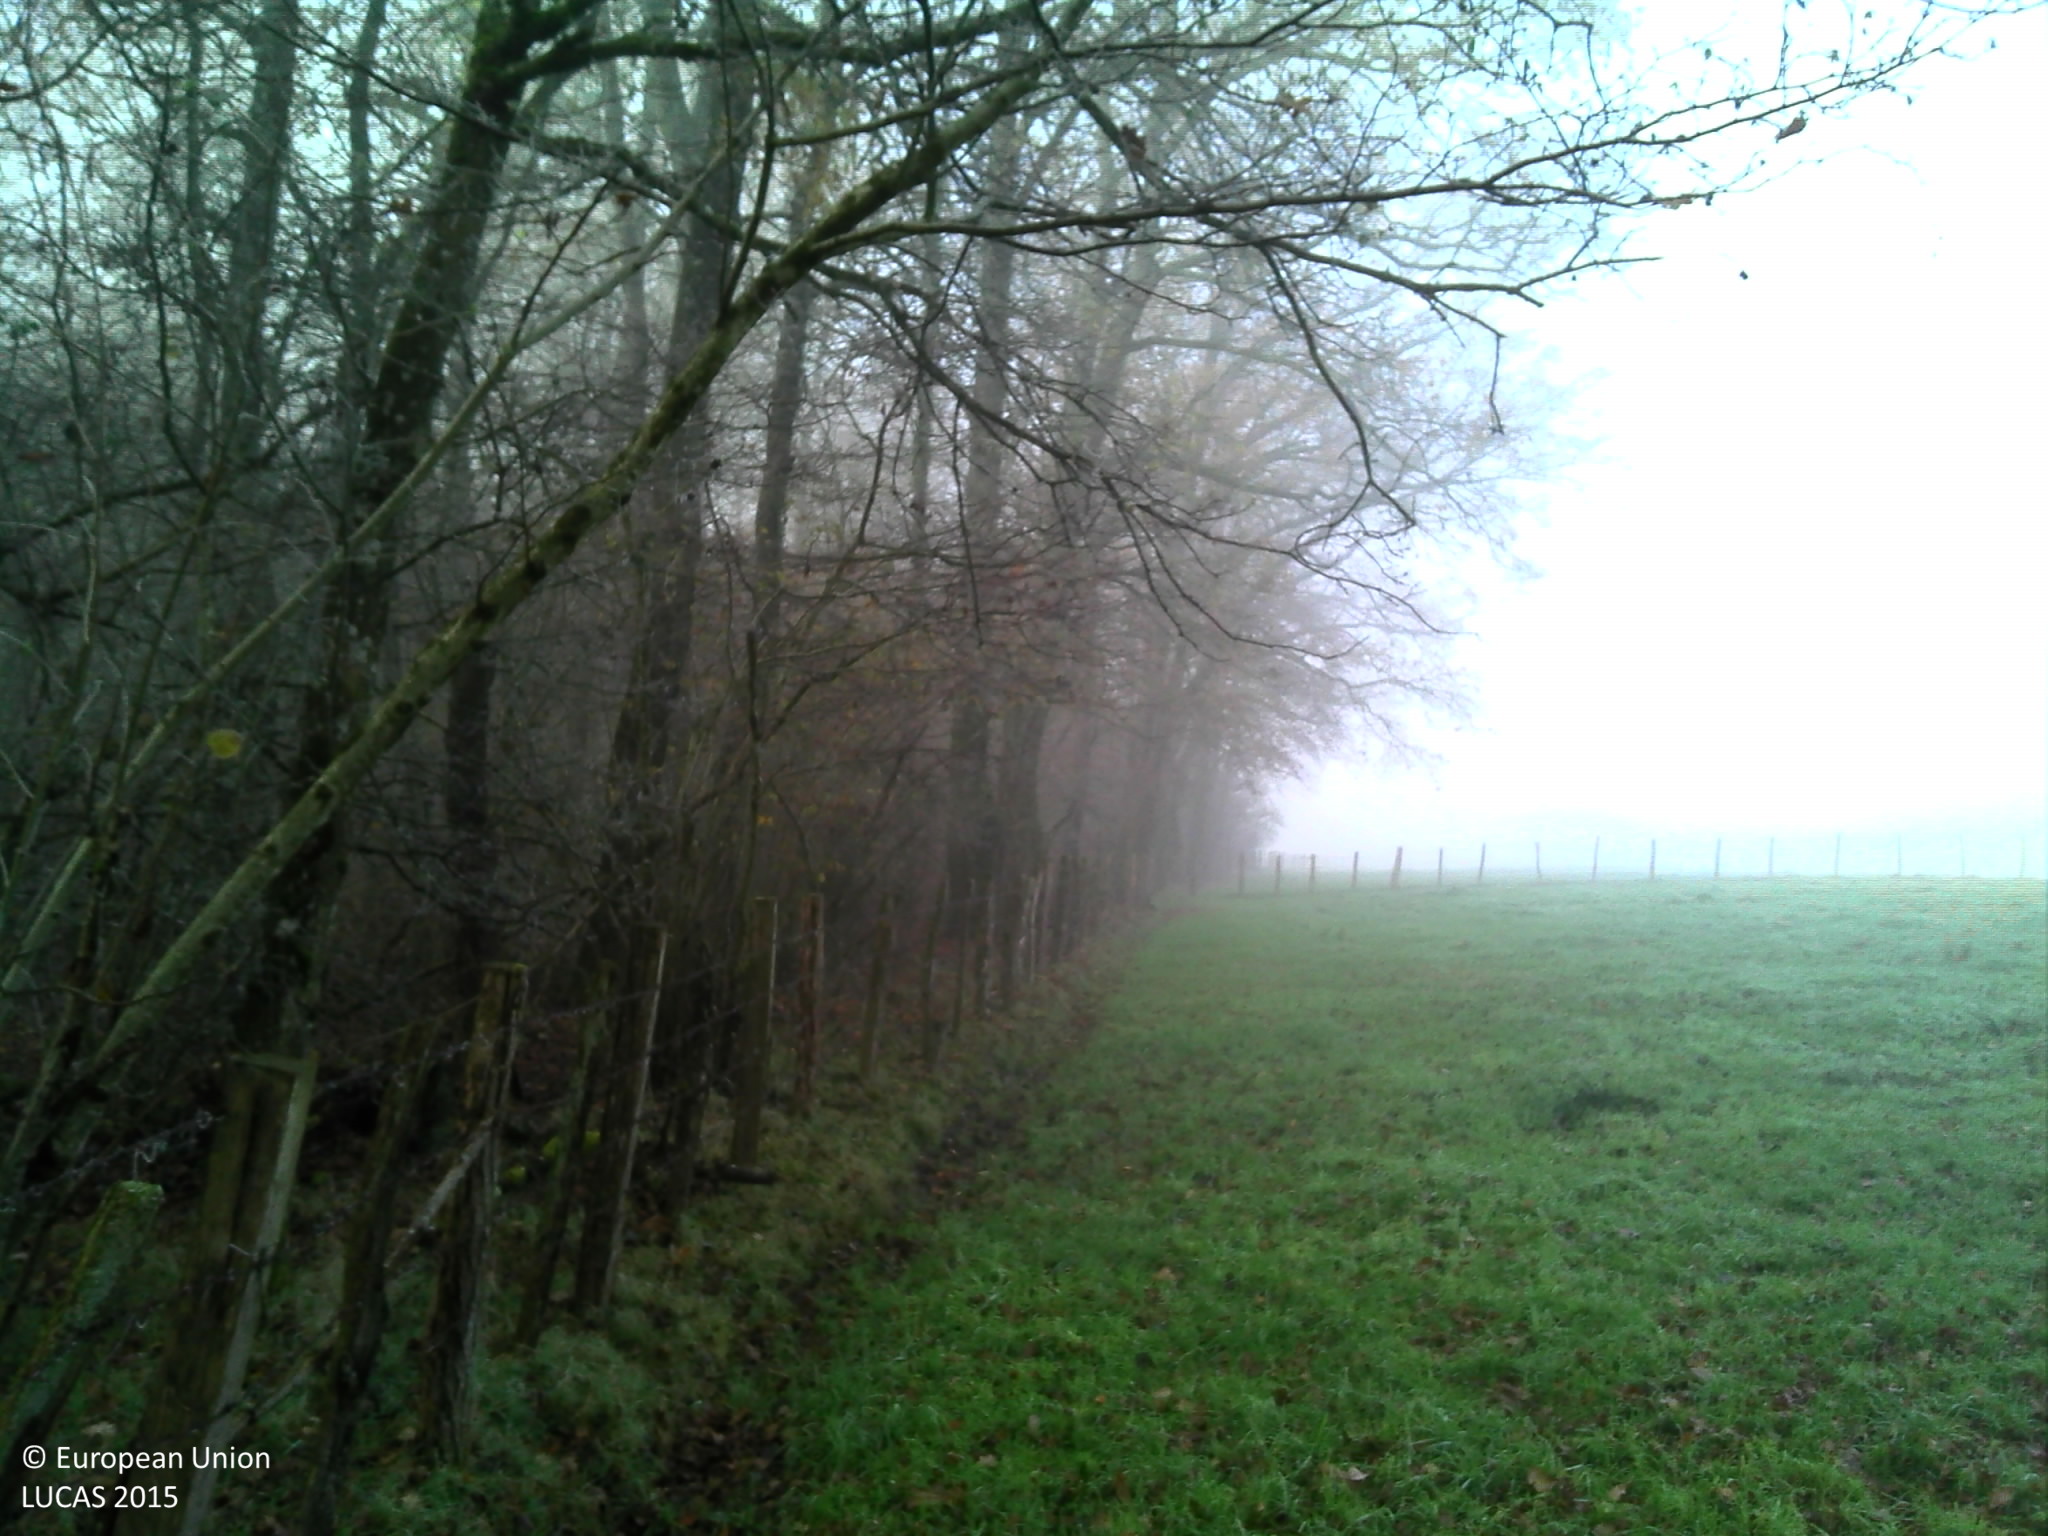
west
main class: Woodland
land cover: Broadleaved woodland
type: mesophytic deciduous forest
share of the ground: > 75 %
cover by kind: broadleaved forest trees 90 %, herbaceous plants 10 %
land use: Agriculture (excluding fallow land and kitchen gardens)
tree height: > 5 m
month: December
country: FR
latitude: 46.4036
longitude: 5.1508
